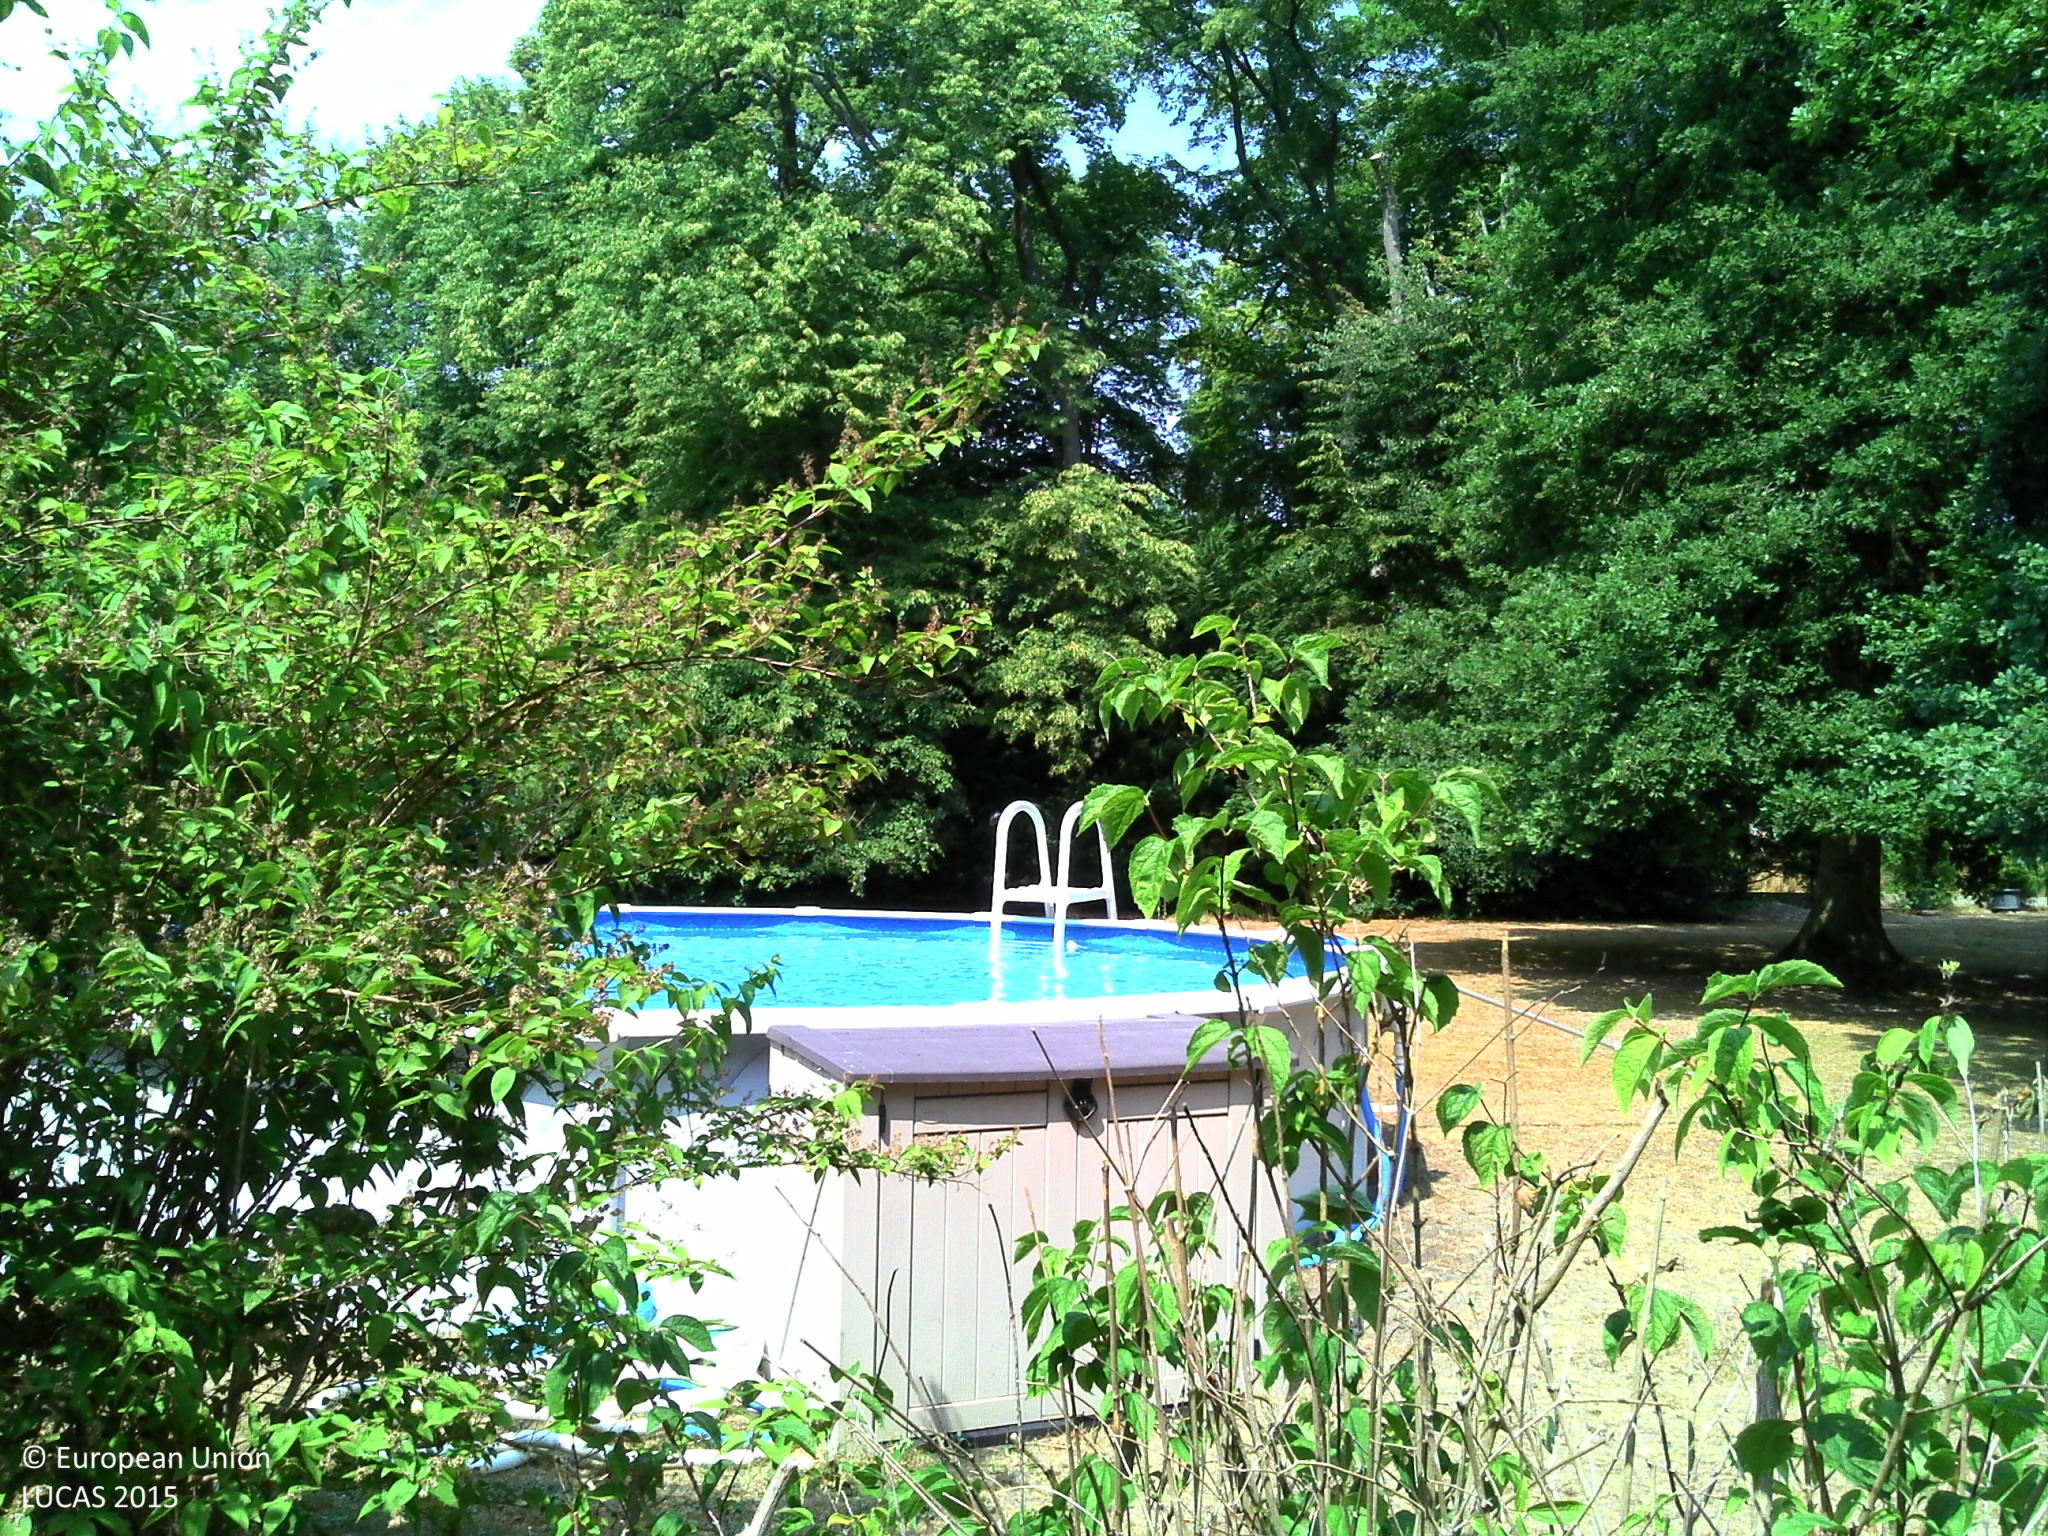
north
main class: Grassland
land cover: Grassland with sparse tree/shrub cover
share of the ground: > 75 %
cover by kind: herbaceous plants 95 %, broadleaved forest trees 5 %
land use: Residential
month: July
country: FR
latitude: 49.1719
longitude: 2.4027
